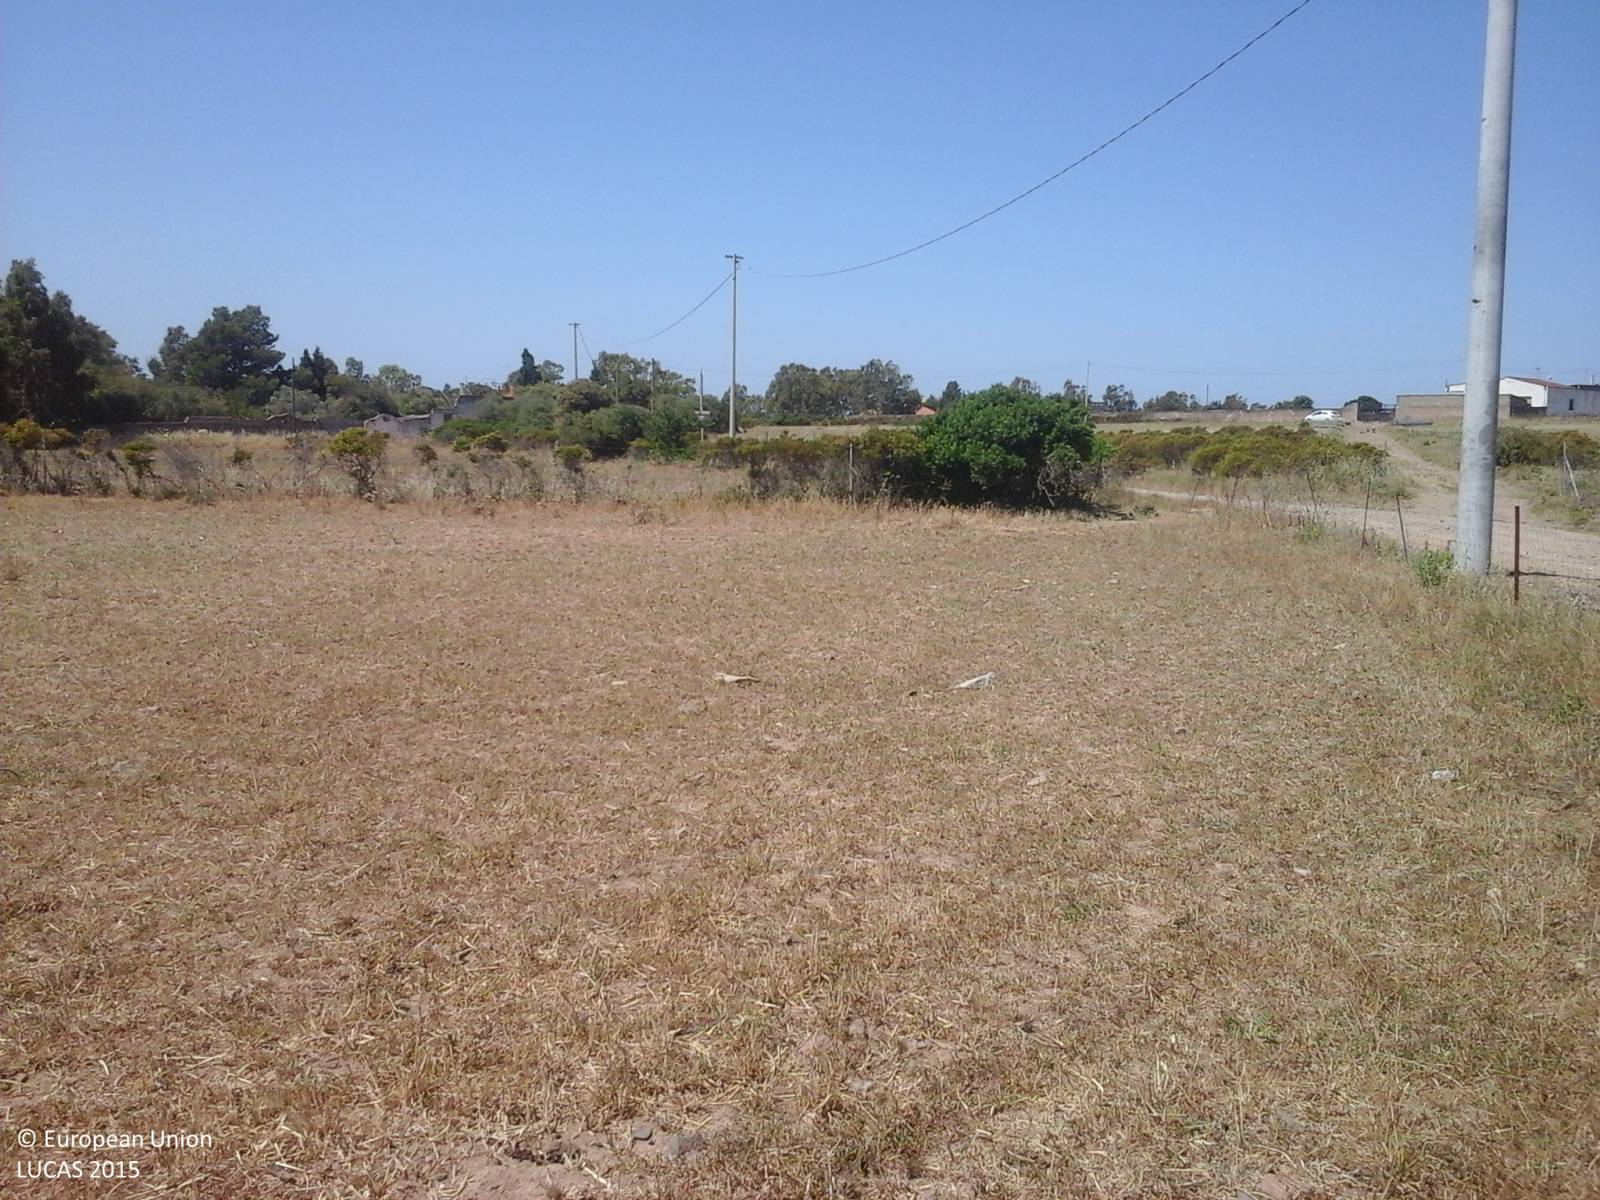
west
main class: Shrubland
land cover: Shrubland without tree cover
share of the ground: > 75 %
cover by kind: herbaceous plants 60 %, consolidated bare surface 25 %, shrubs 15 %
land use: Agriculture (excluding fallow land and kitchen gardens)
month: June
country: IT
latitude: 38.9903
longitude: 8.6808
